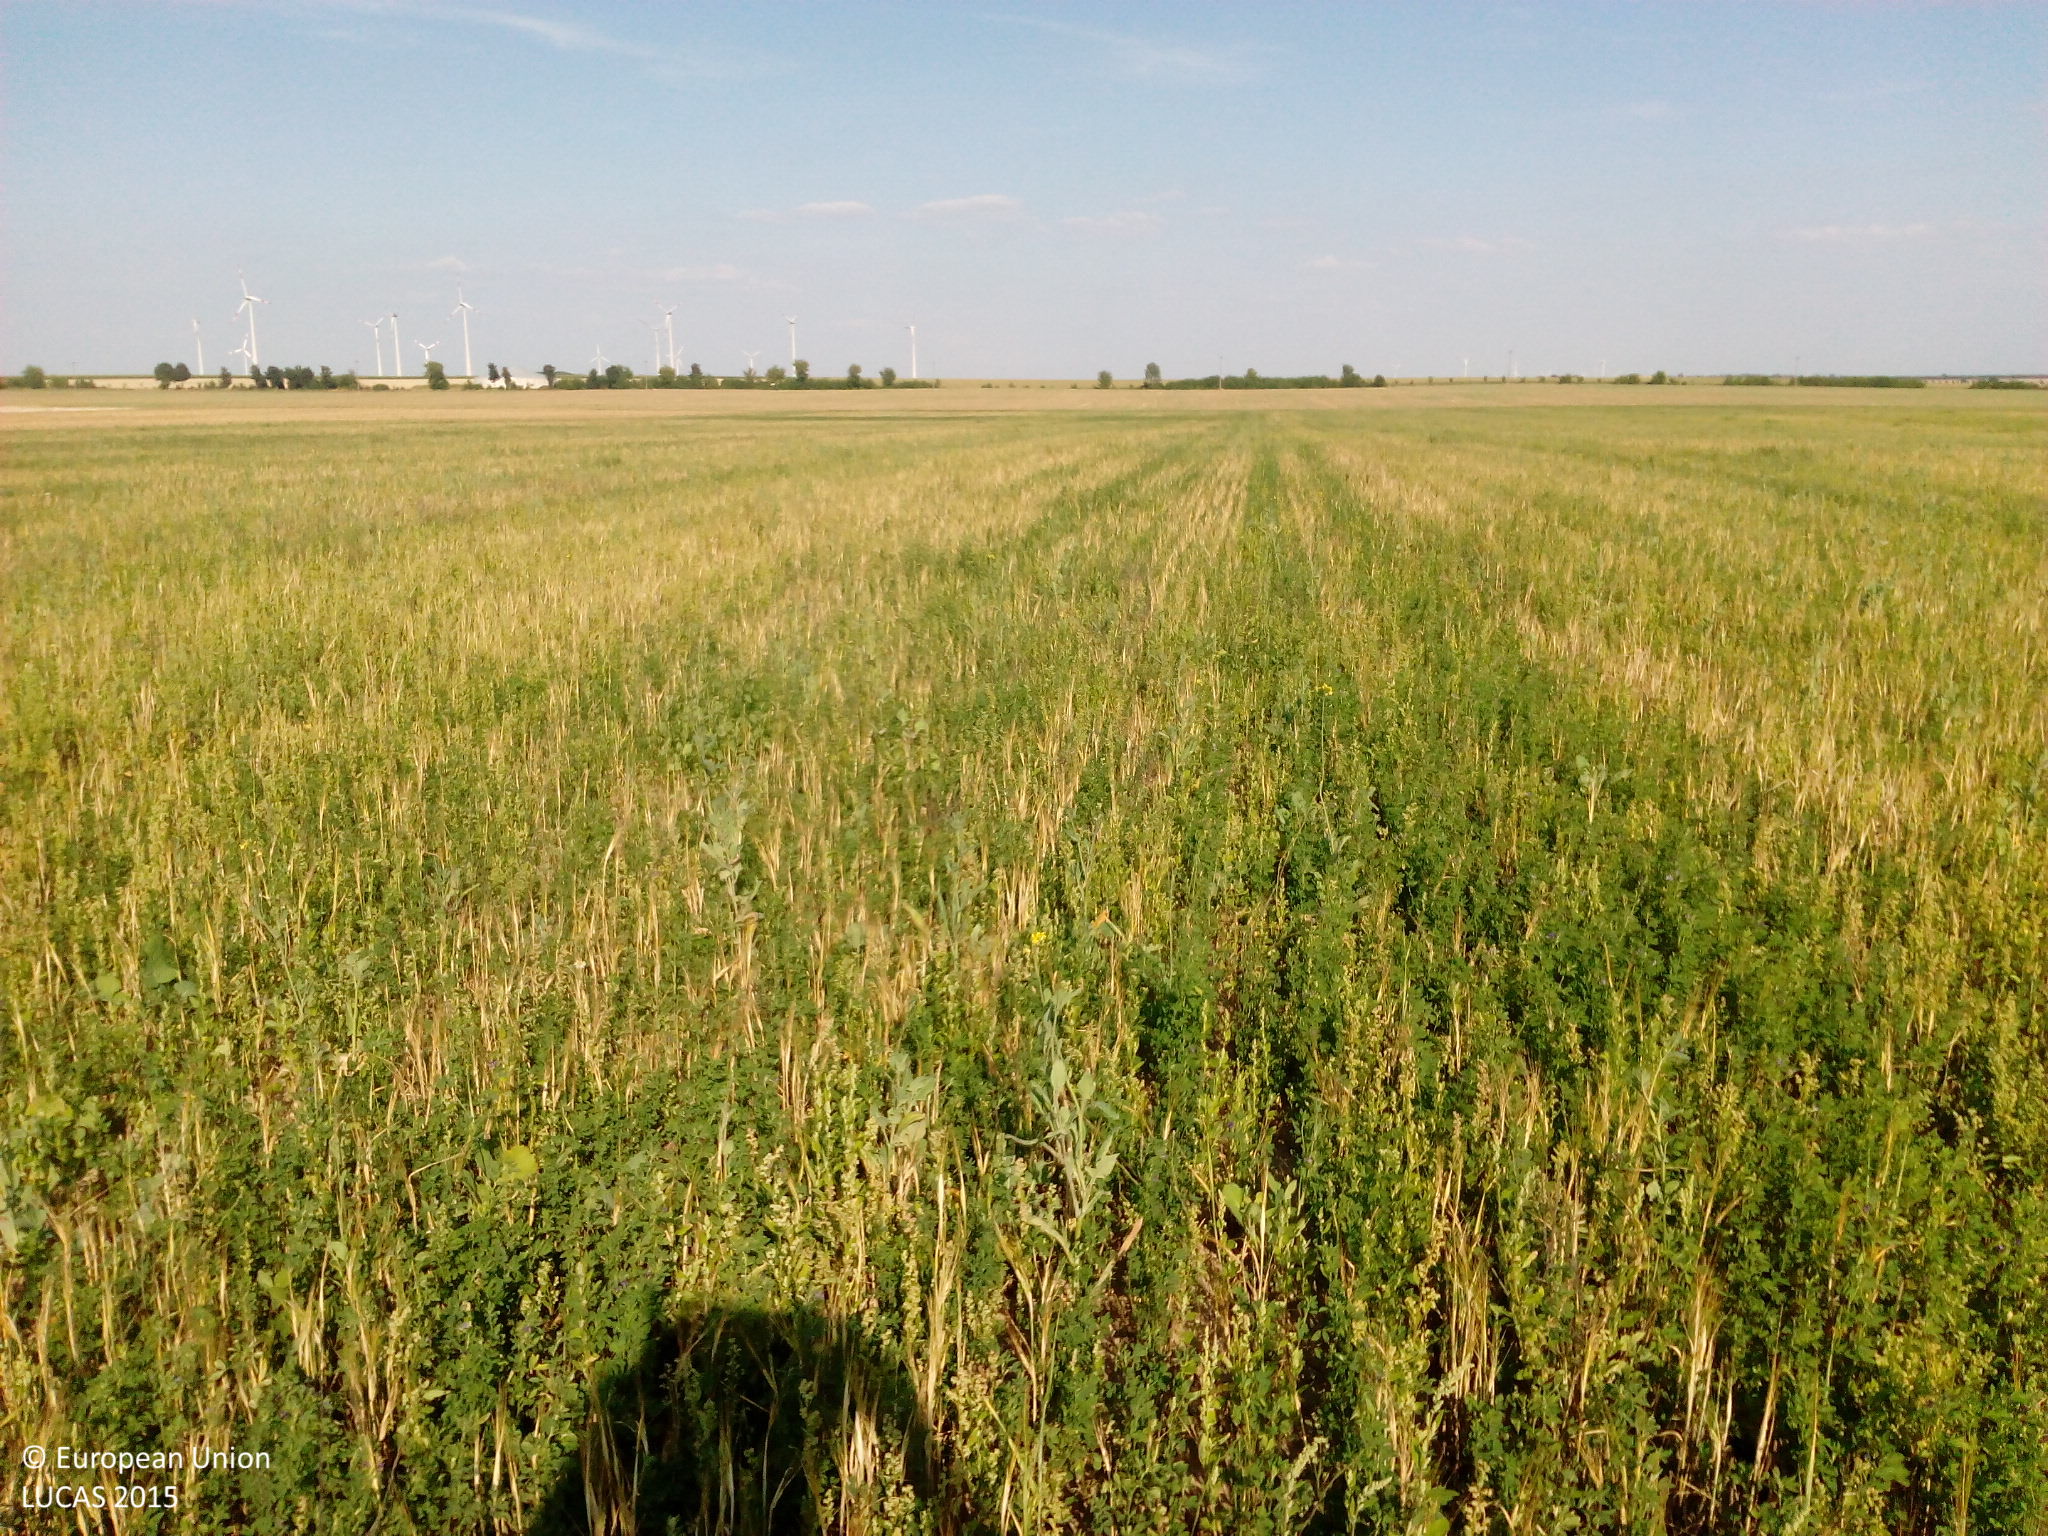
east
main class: Cropland
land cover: Barley
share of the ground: 10 - 25 %
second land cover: Clovers
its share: 50 - 75 %
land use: Agriculture (excluding fallow land and kitchen gardens)
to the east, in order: Barley; Clovers
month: August
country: DE
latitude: 51.9406
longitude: 13.1275
